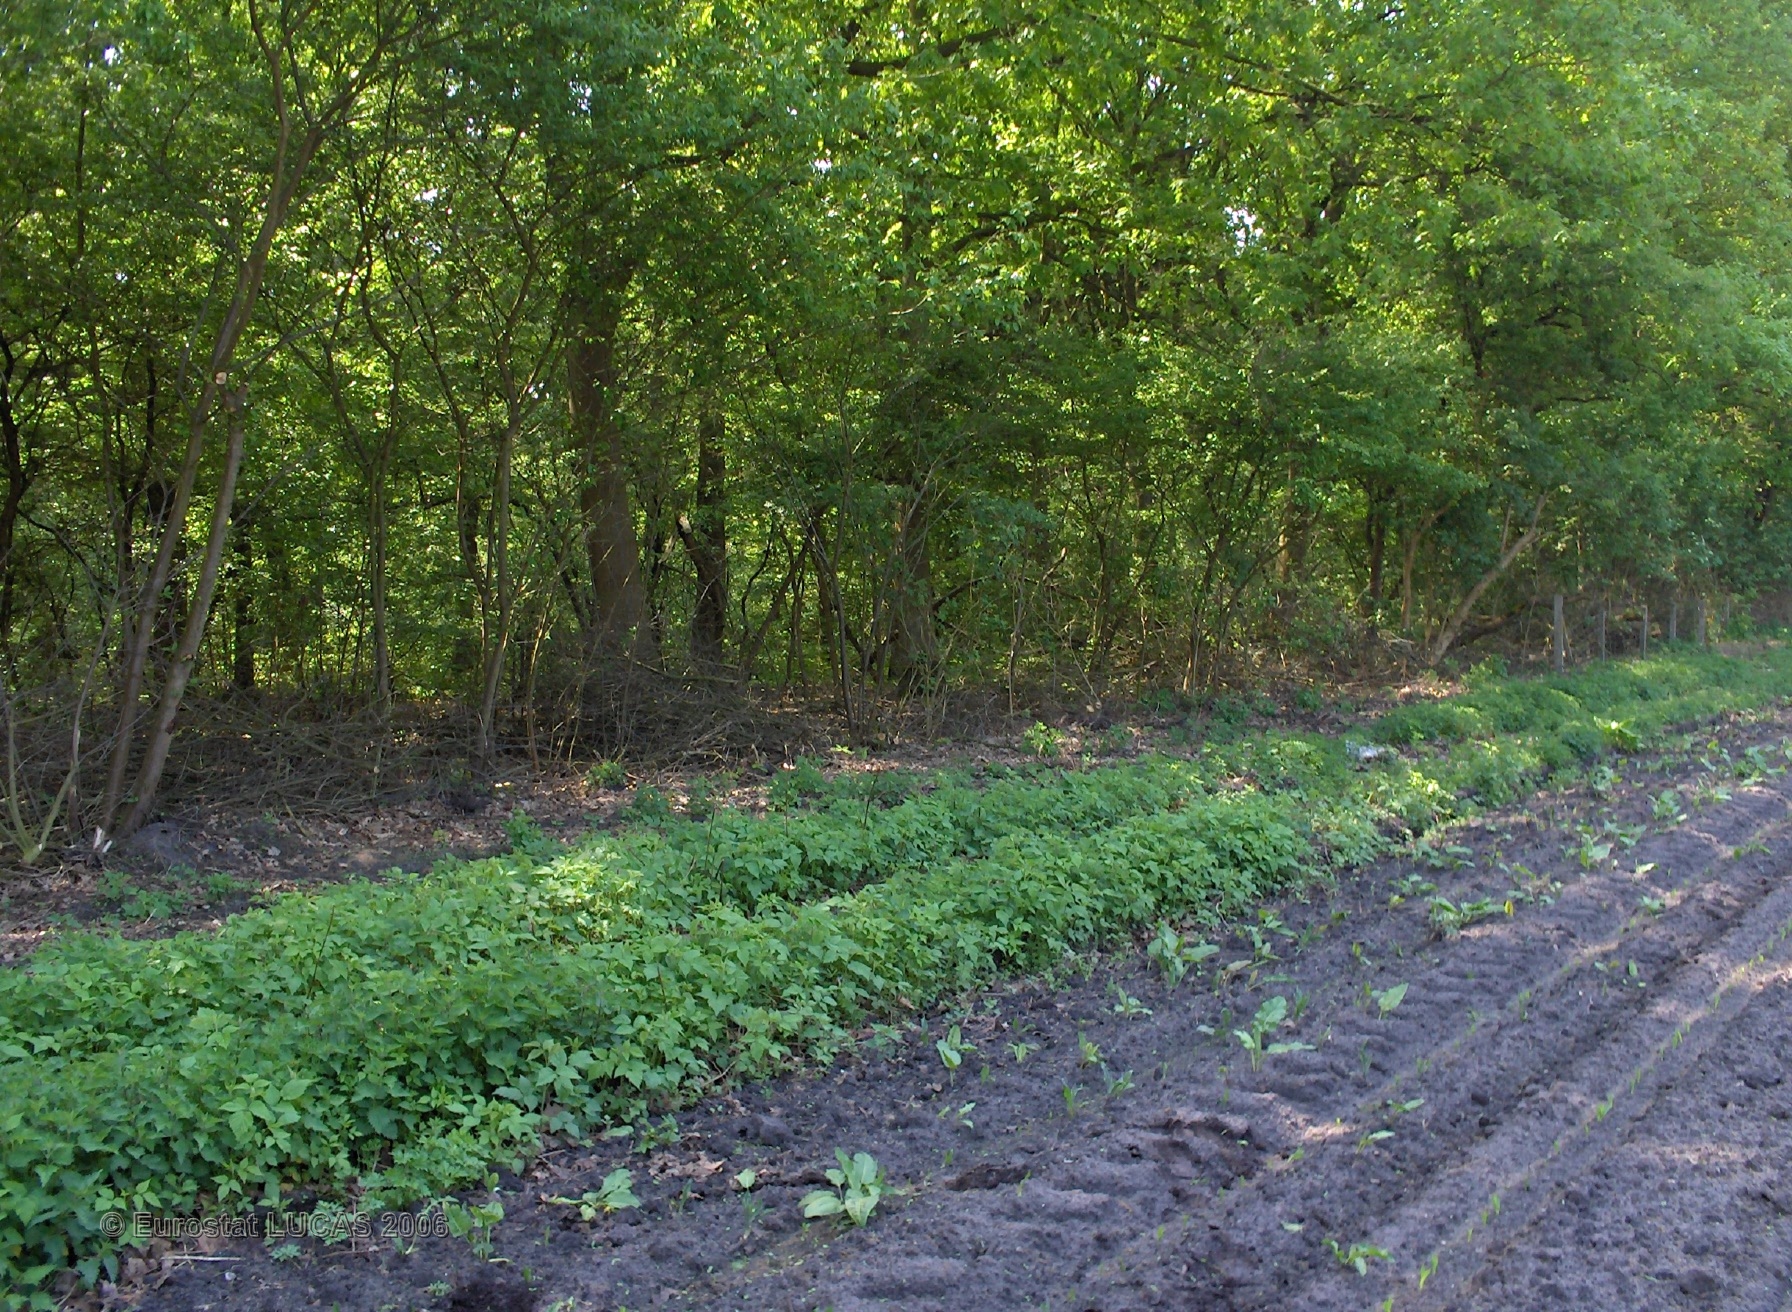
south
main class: Cropland
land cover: Maize
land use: Agriculture (excluding fallow land and kitchen gardens)
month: May
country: BE
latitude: 51.2897
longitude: 5.1938
